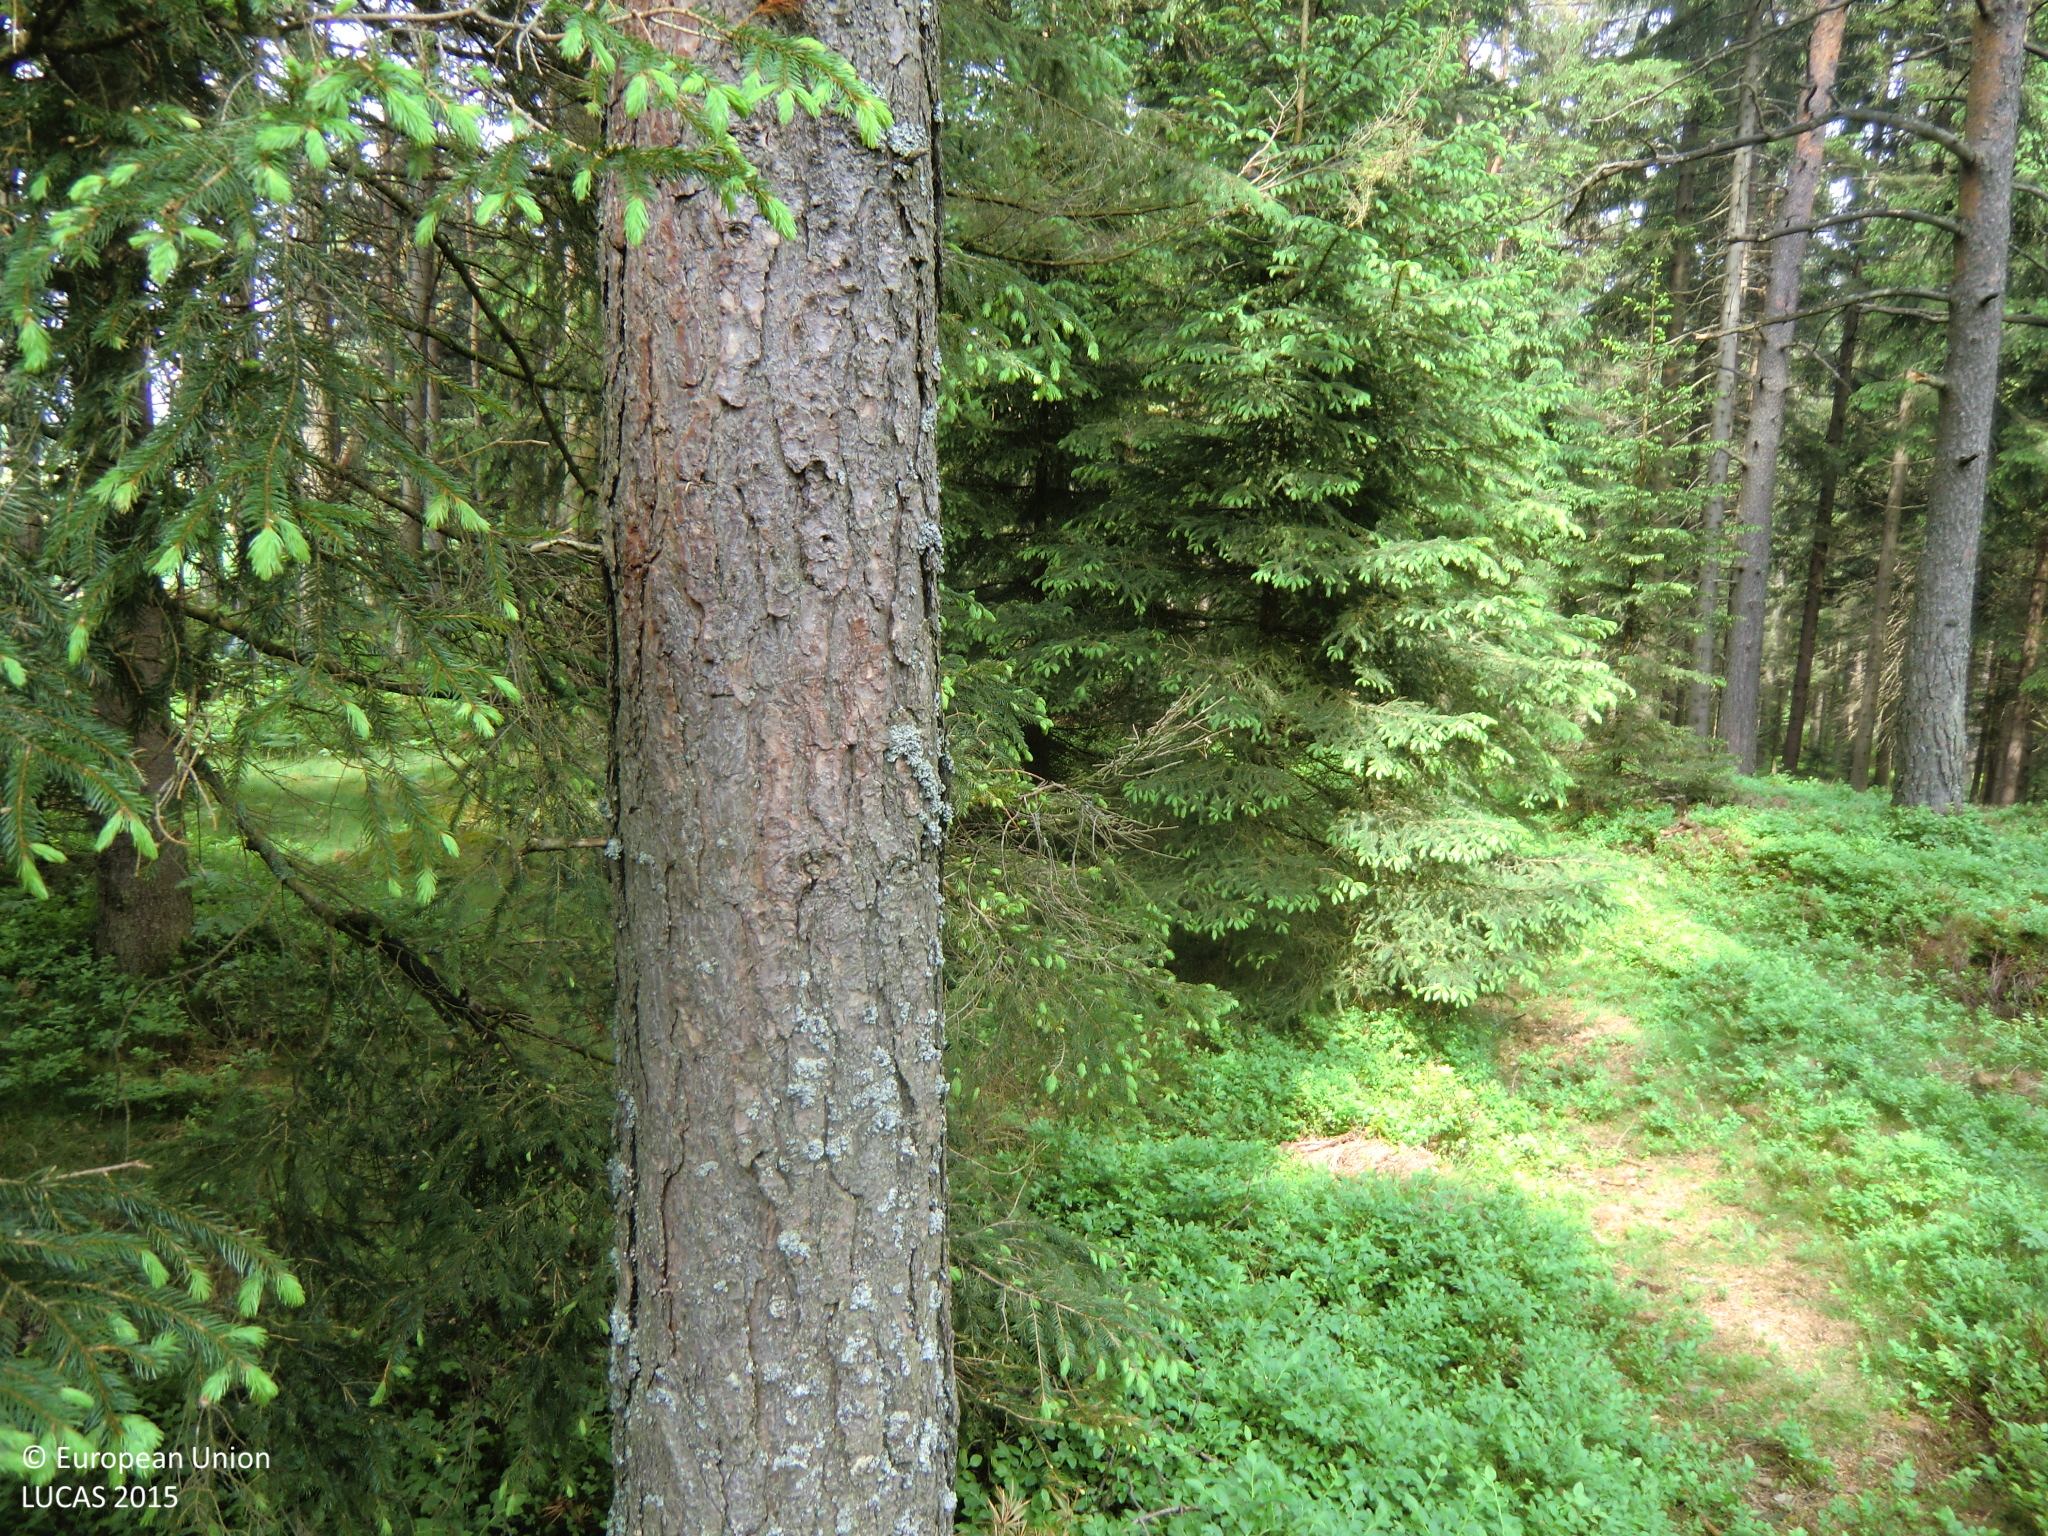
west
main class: Woodland
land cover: Pine dominated coniferous woodland
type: hemiboreal forest and nemoral coniferous forest and mixed broadleaved-coniferous forest
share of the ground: > 75 %
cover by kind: coniferous forest trees 80 %, shrubs 20 %
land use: Forestry
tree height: > 5 m
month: June
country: AT
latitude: 48.6062
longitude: 14.7887
